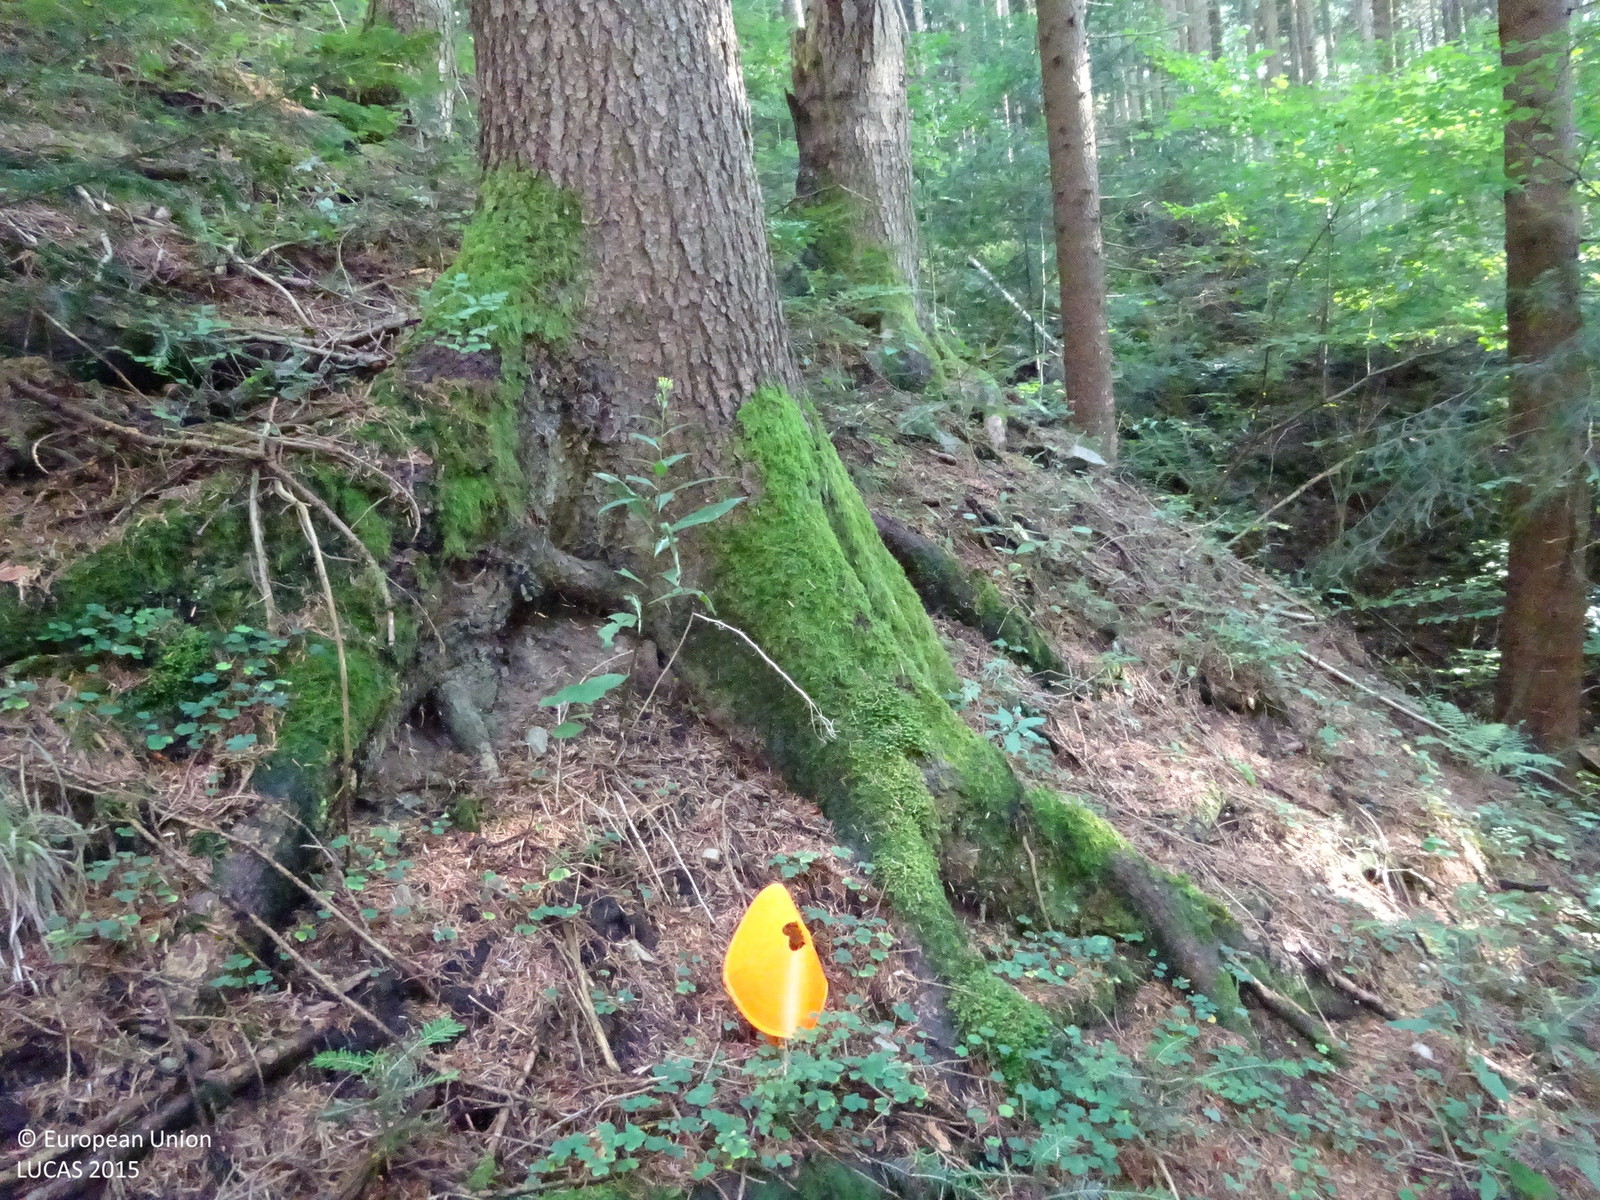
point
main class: Woodland
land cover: Spruce dominated coniferous woodland
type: alpine coniferous forest
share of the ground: > 75 %
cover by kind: coniferous forest trees 100 %
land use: Forestry
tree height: > 5 m
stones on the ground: < 10 %
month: August
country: AT
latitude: 47.3541
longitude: 15.7070
